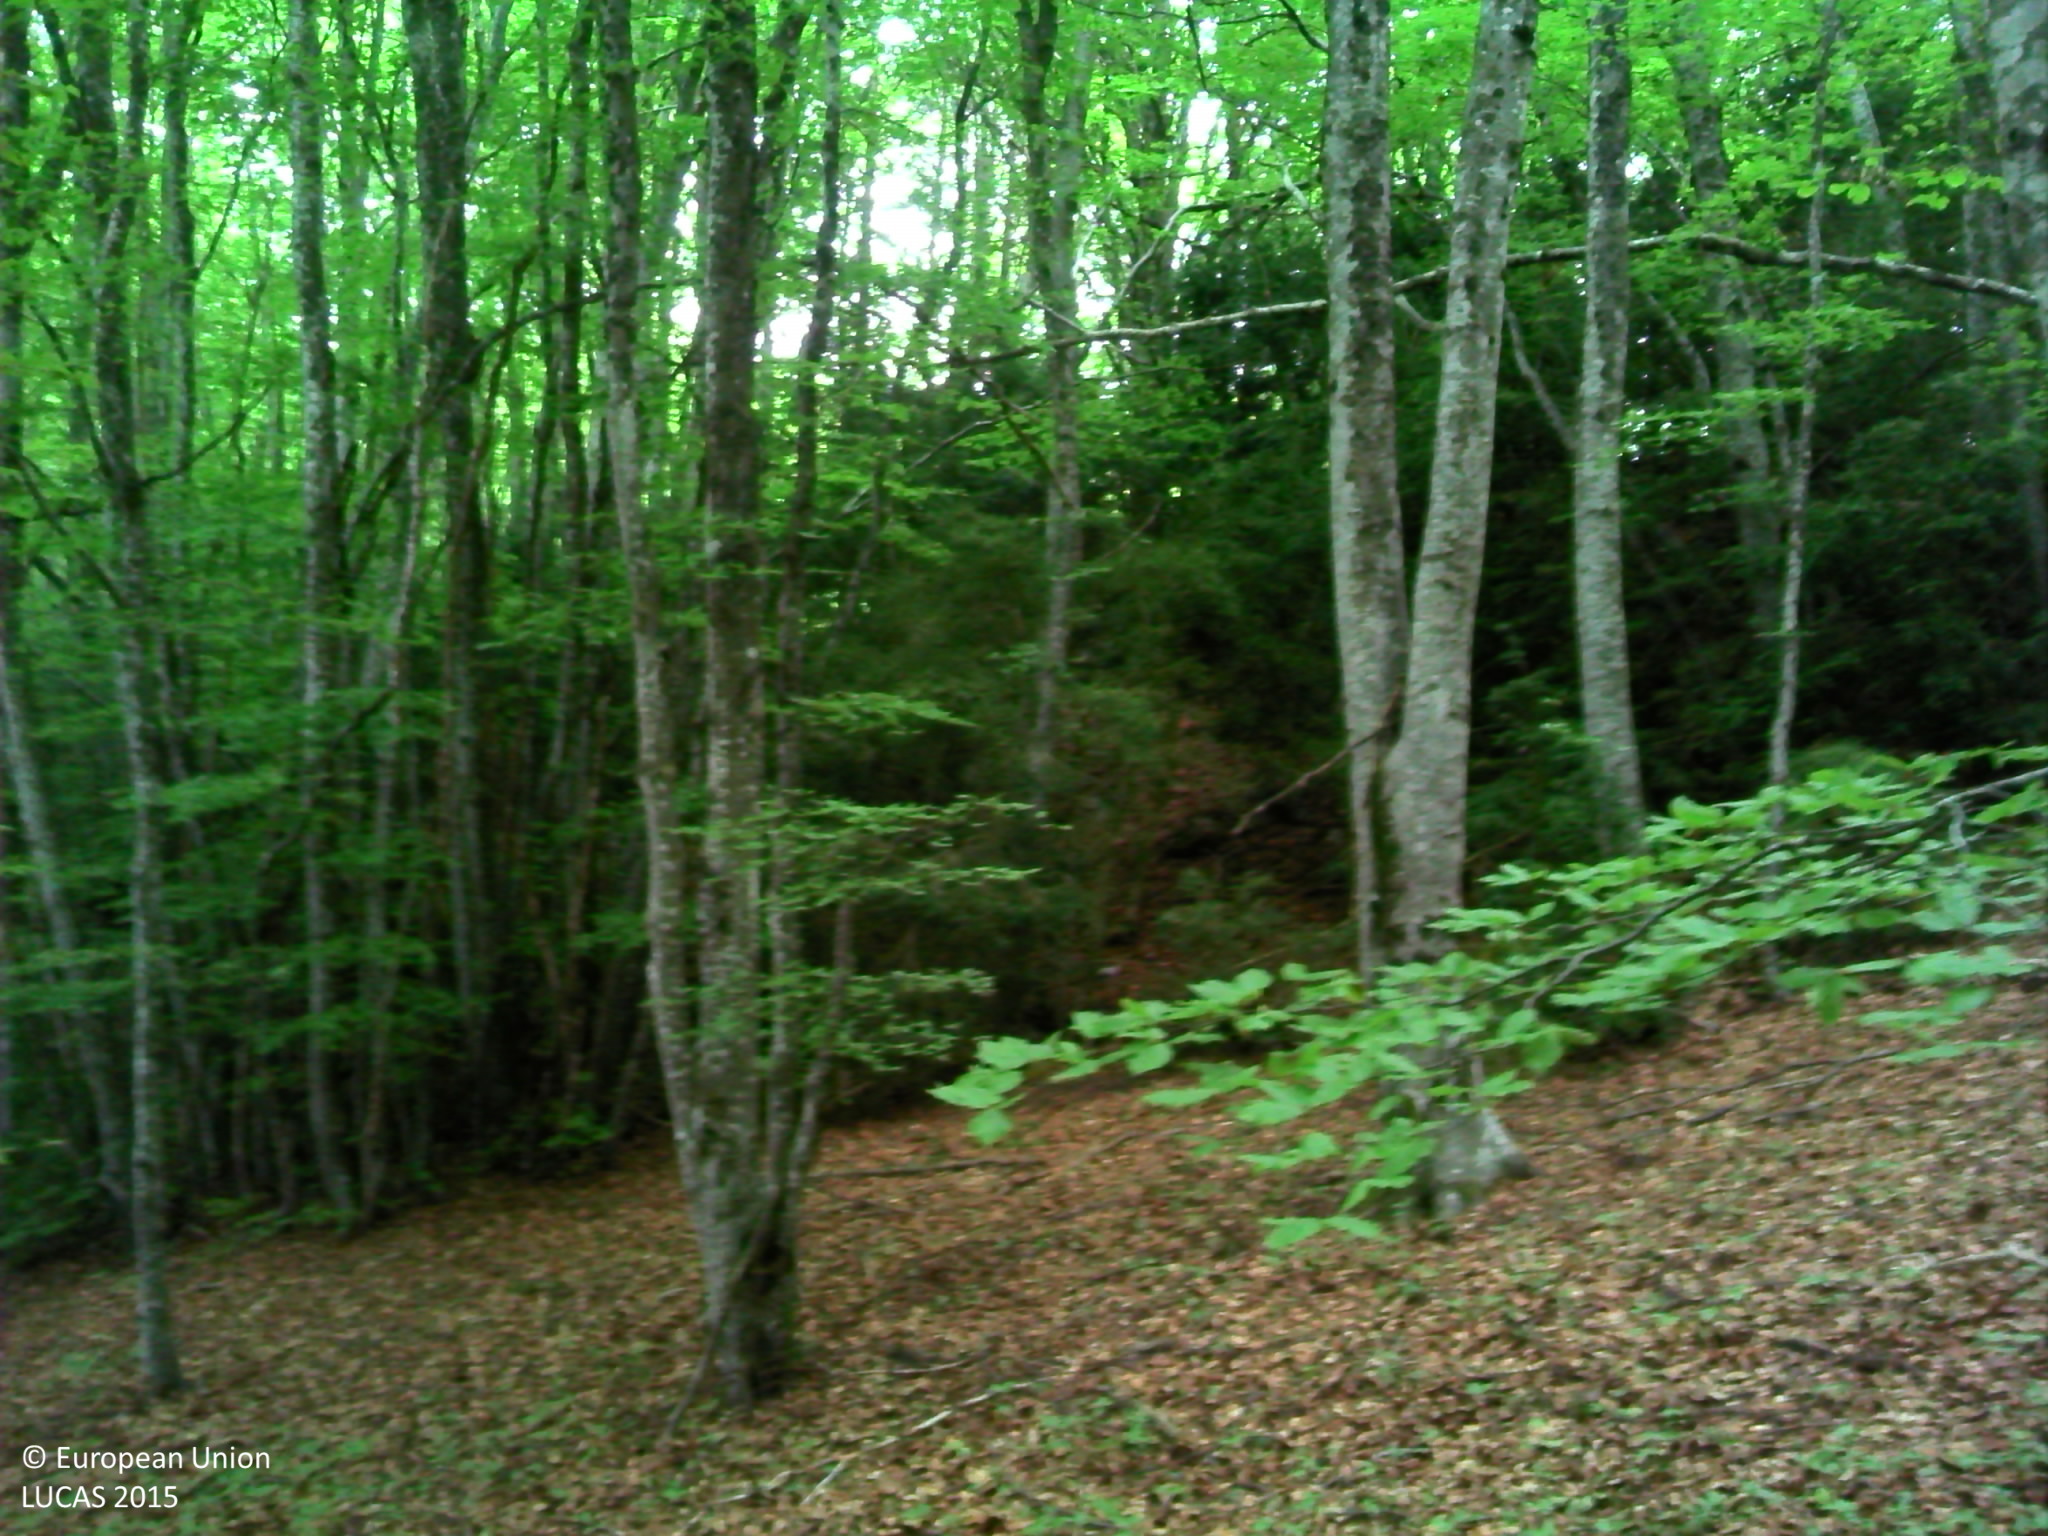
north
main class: Woodland
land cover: Broadleaved woodland
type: beech forest
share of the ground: > 75 %
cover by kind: broadleaved forest trees 95 %, lichens and mosses 5 %
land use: Semi-natural and natural areas not in use
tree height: > 5 m
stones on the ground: < 10 %
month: May
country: FR
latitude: 44.8877
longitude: 5.1568
